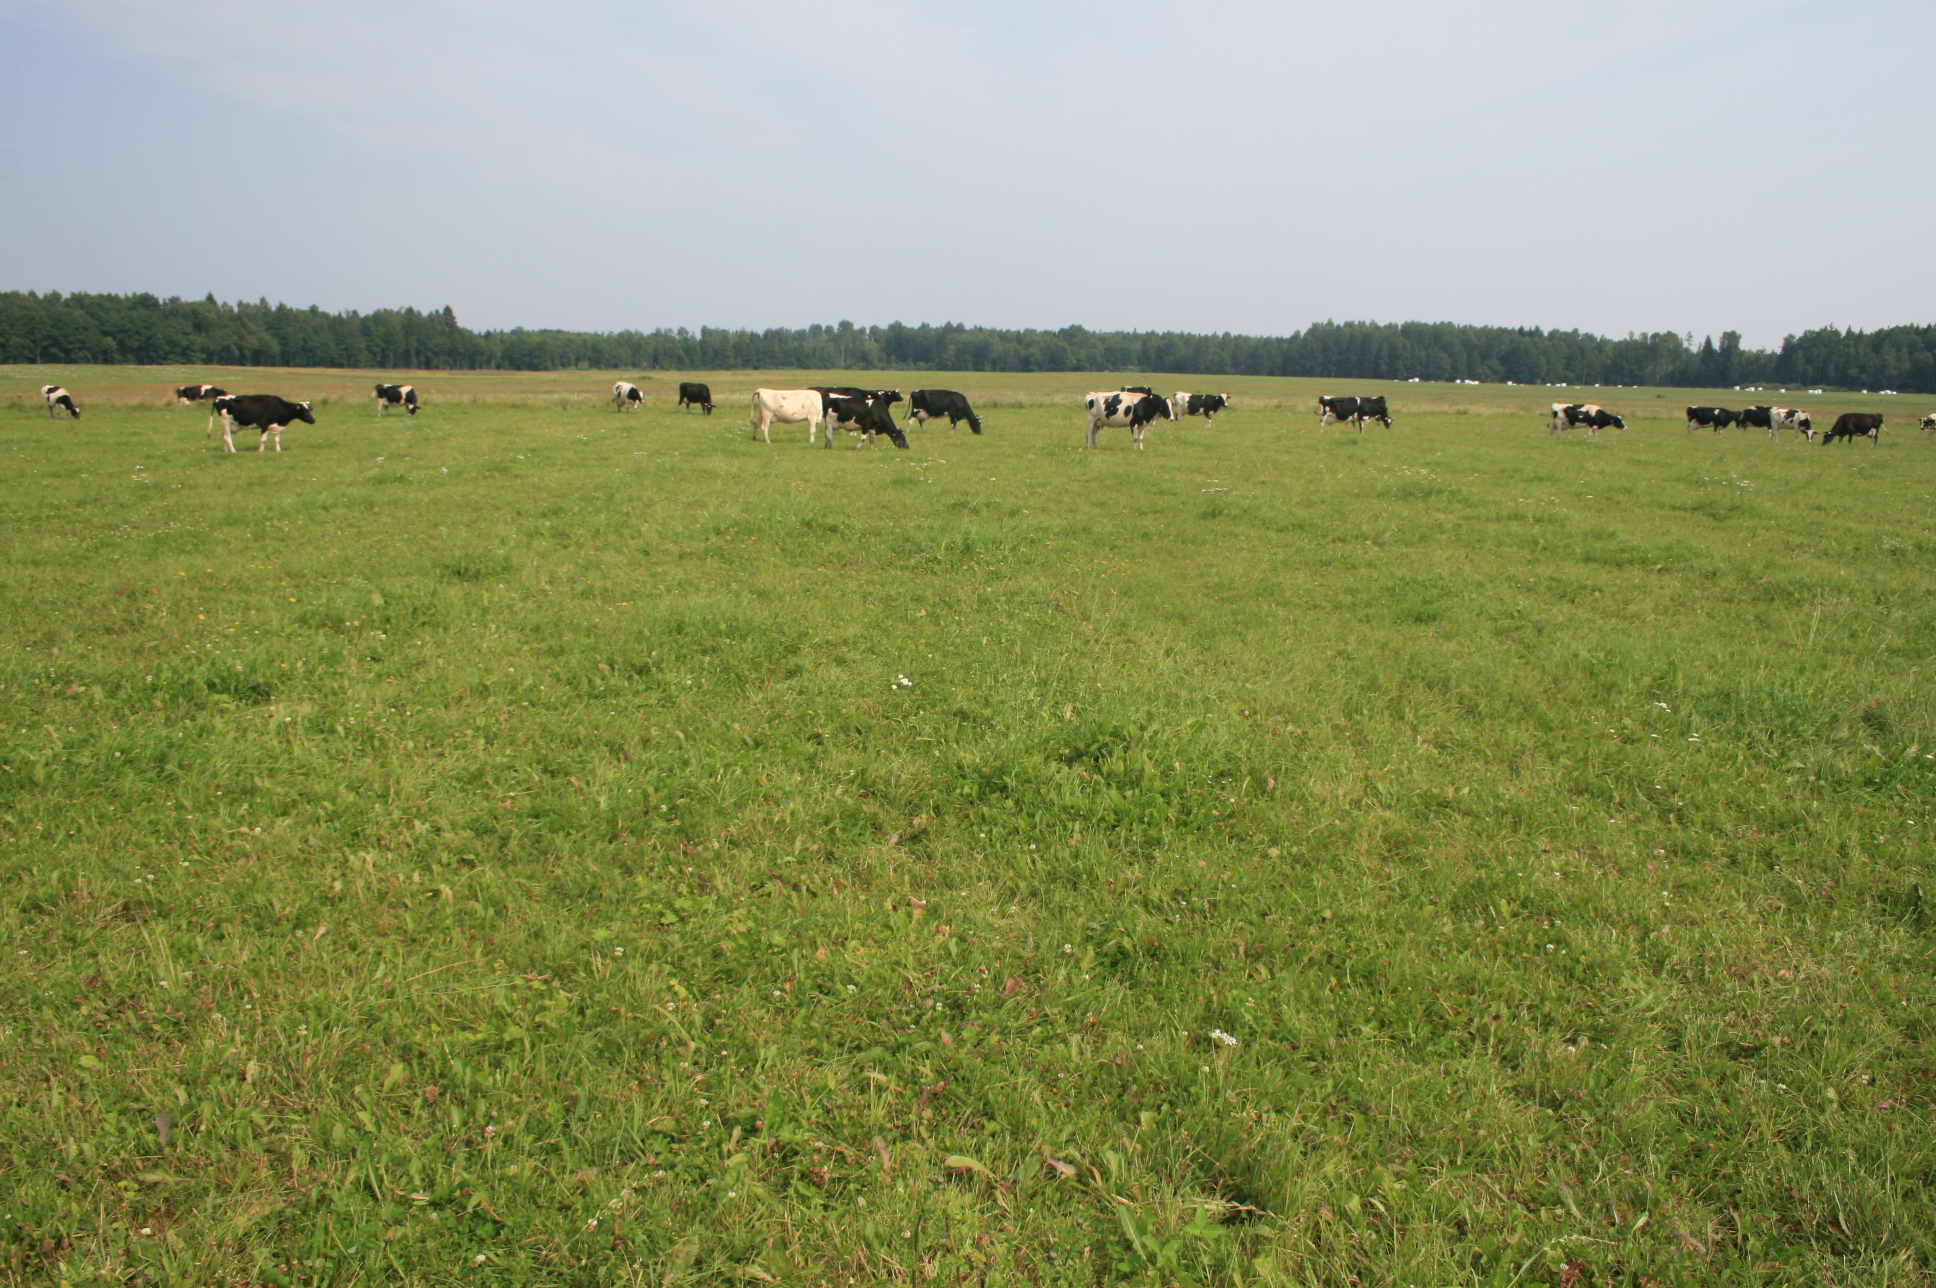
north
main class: Grassland
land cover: Grassland without tree/shrub cover
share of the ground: > 75 %
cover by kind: herbaceous plants 100 %
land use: Agriculture (excluding fallow land and kitchen gardens)
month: August
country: LT
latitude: 55.5800
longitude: 21.8687
